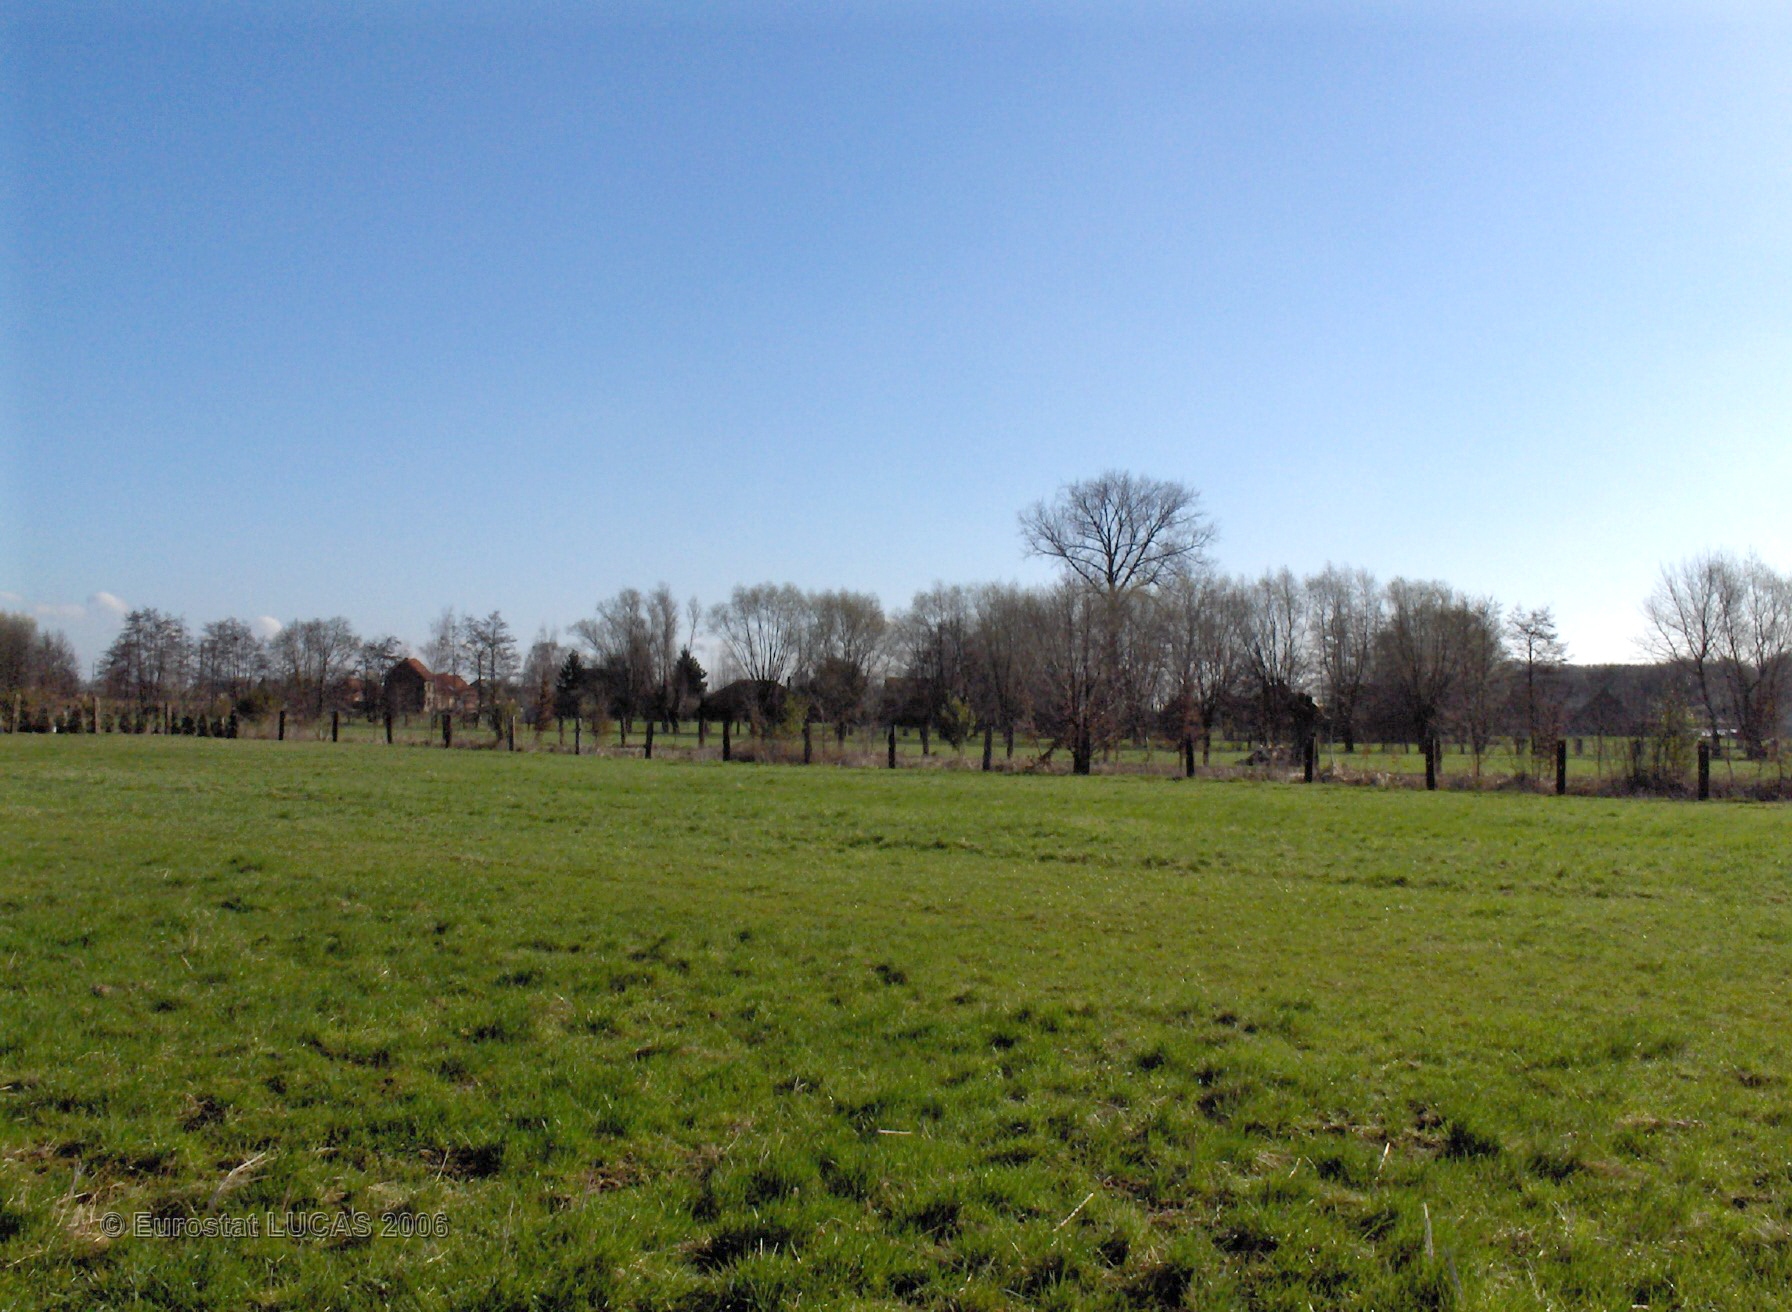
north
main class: Grassland
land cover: Grassland without tree/shrub cover
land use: Agriculture (excluding fallow land and kitchen gardens)
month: April
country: BE
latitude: 50.9851
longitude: 4.4257
